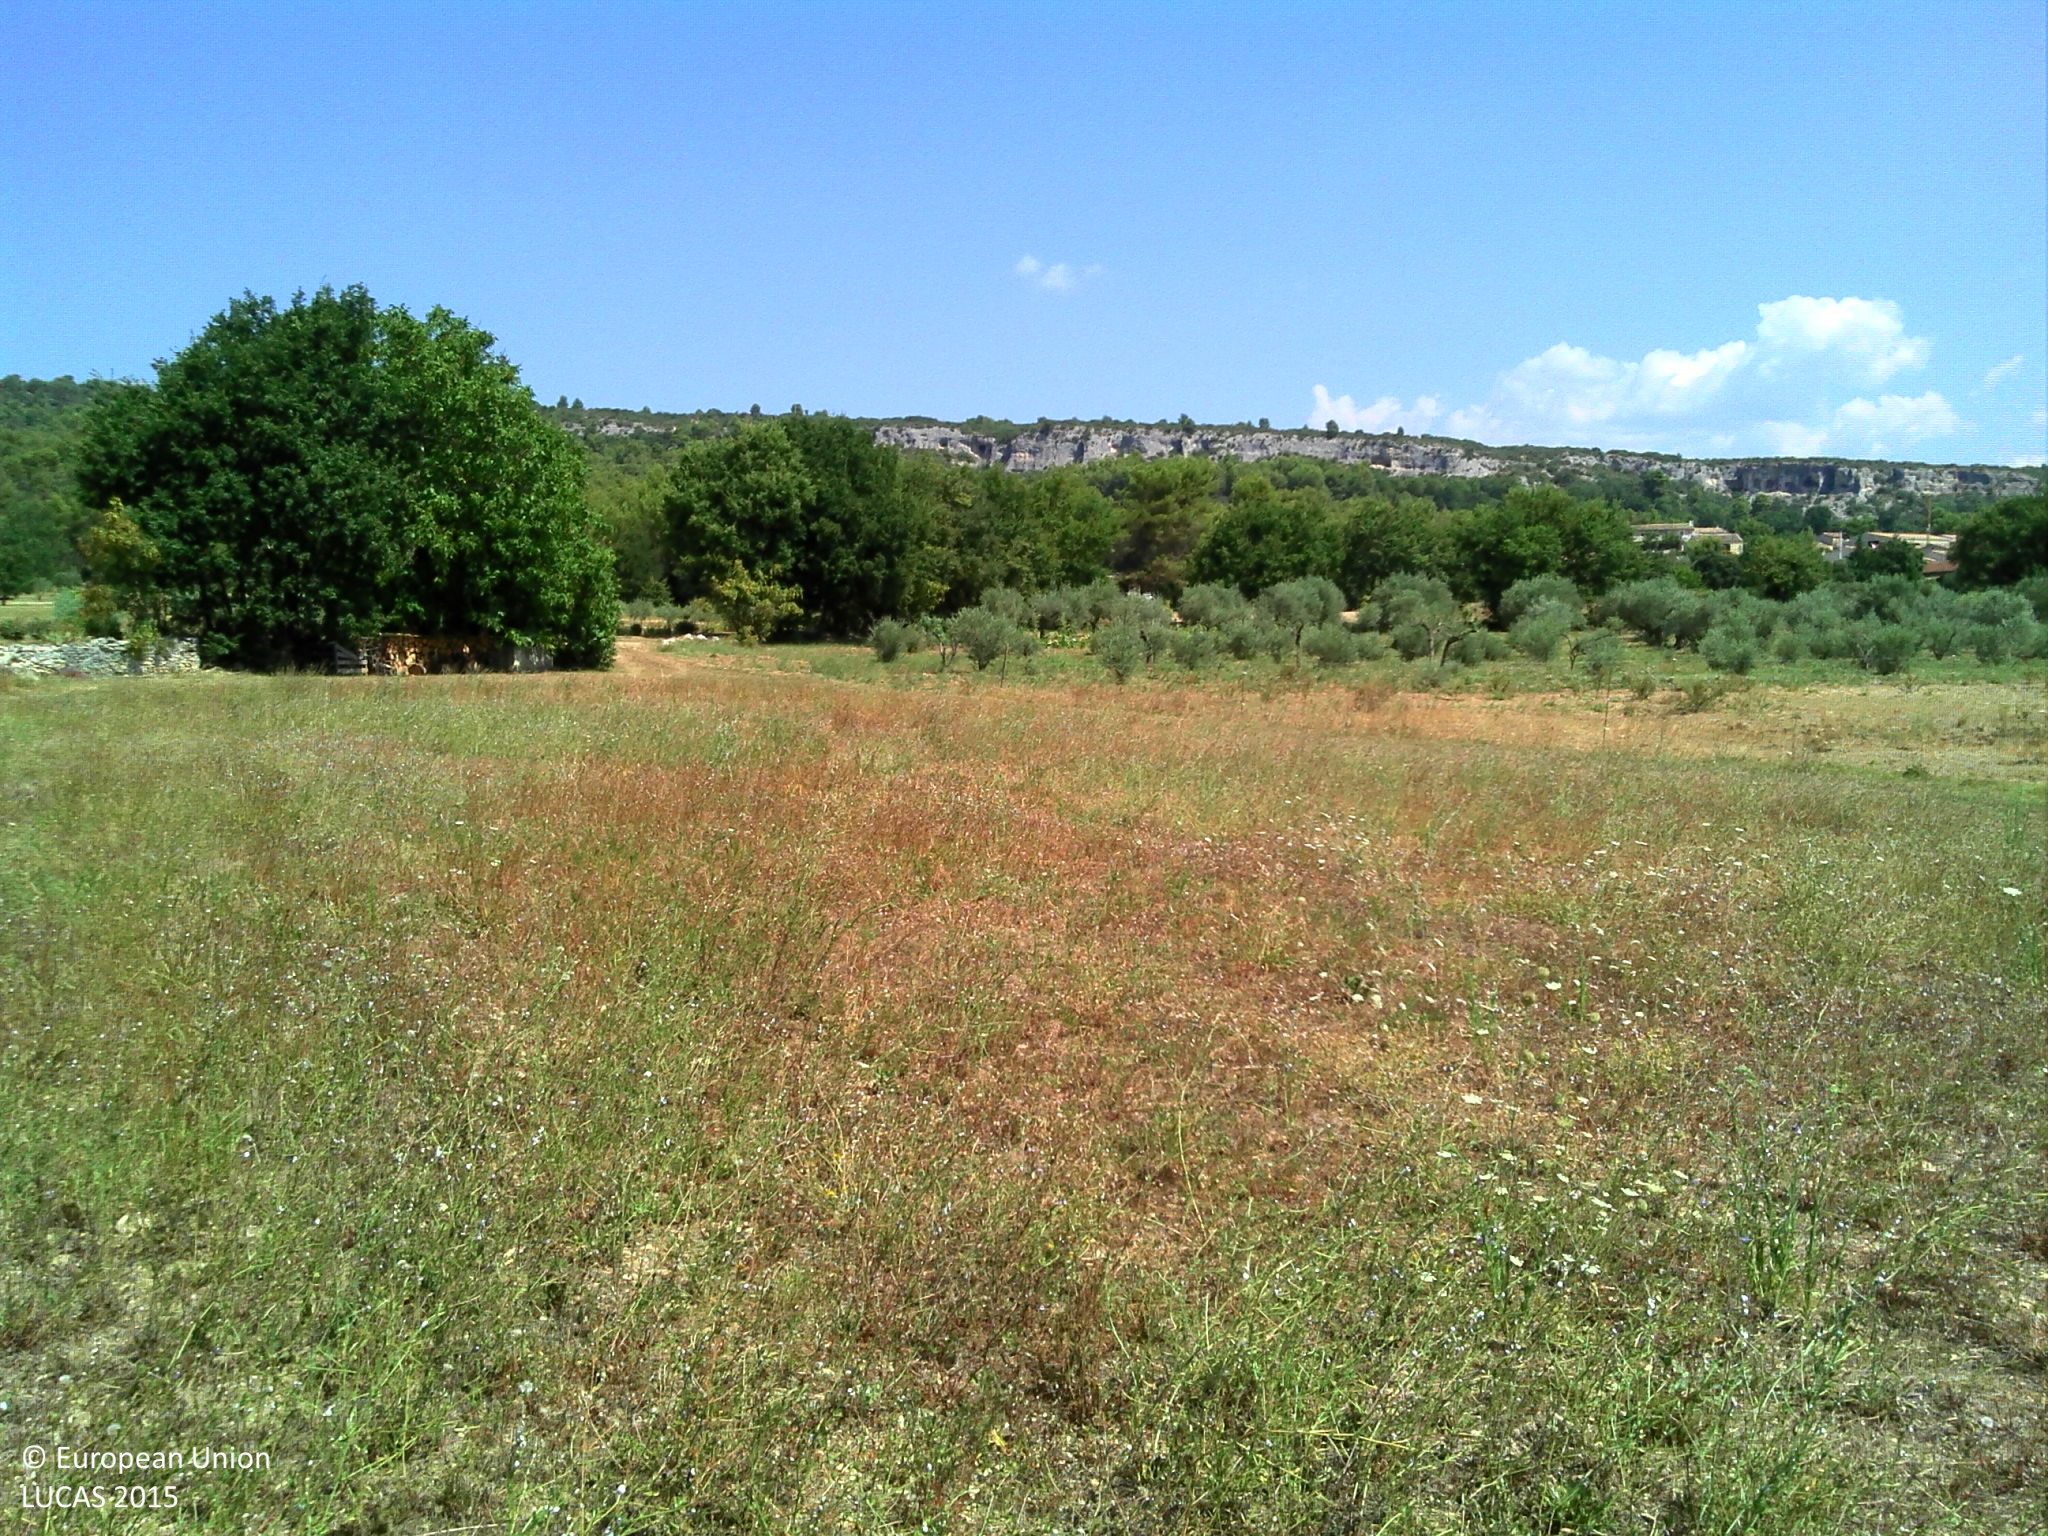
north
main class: Grassland
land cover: Grassland without tree/shrub cover
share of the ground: > 75 %
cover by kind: herbaceous plants 90 %, consolidated bare surface 10 %
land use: Agriculture (excluding fallow land and kitchen gardens)
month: August
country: FR
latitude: 43.9161
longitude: 5.2390
